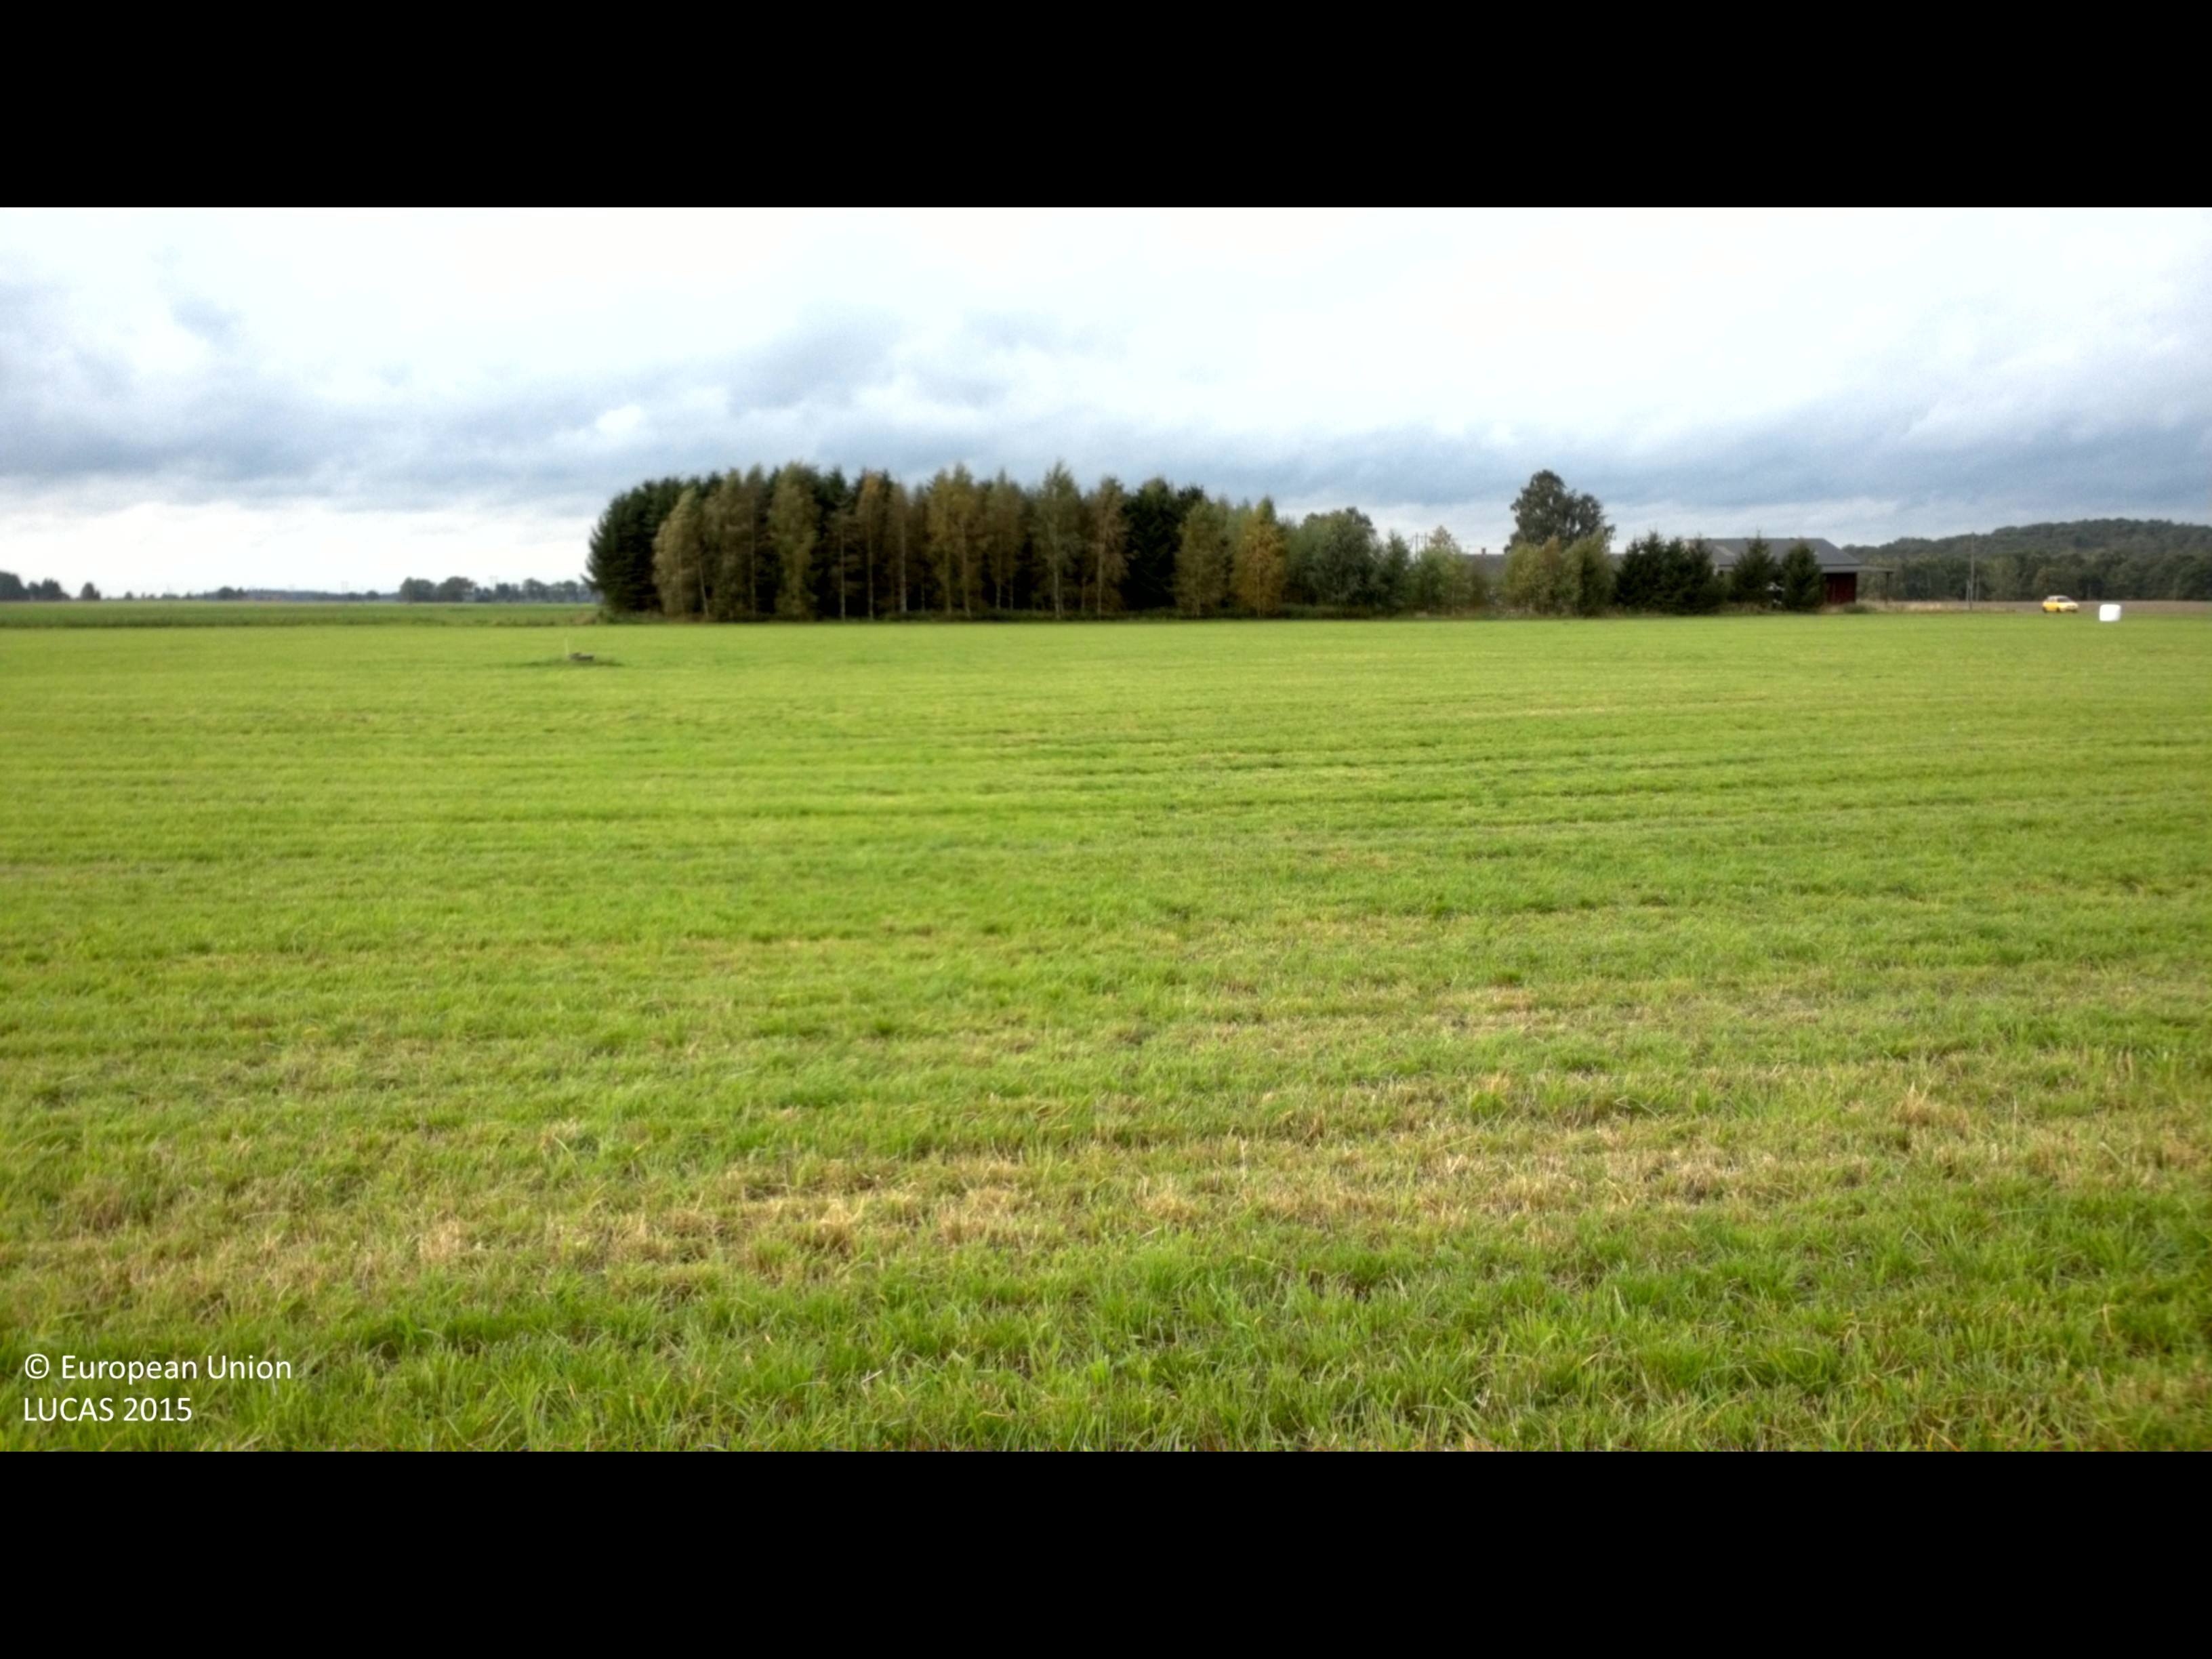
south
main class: Cropland
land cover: Temporary grasslands
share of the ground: > 75 %
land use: Agriculture (excluding fallow land and kitchen gardens)
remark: Harvested field
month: September
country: SE
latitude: 56.2120
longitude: 14.1090
